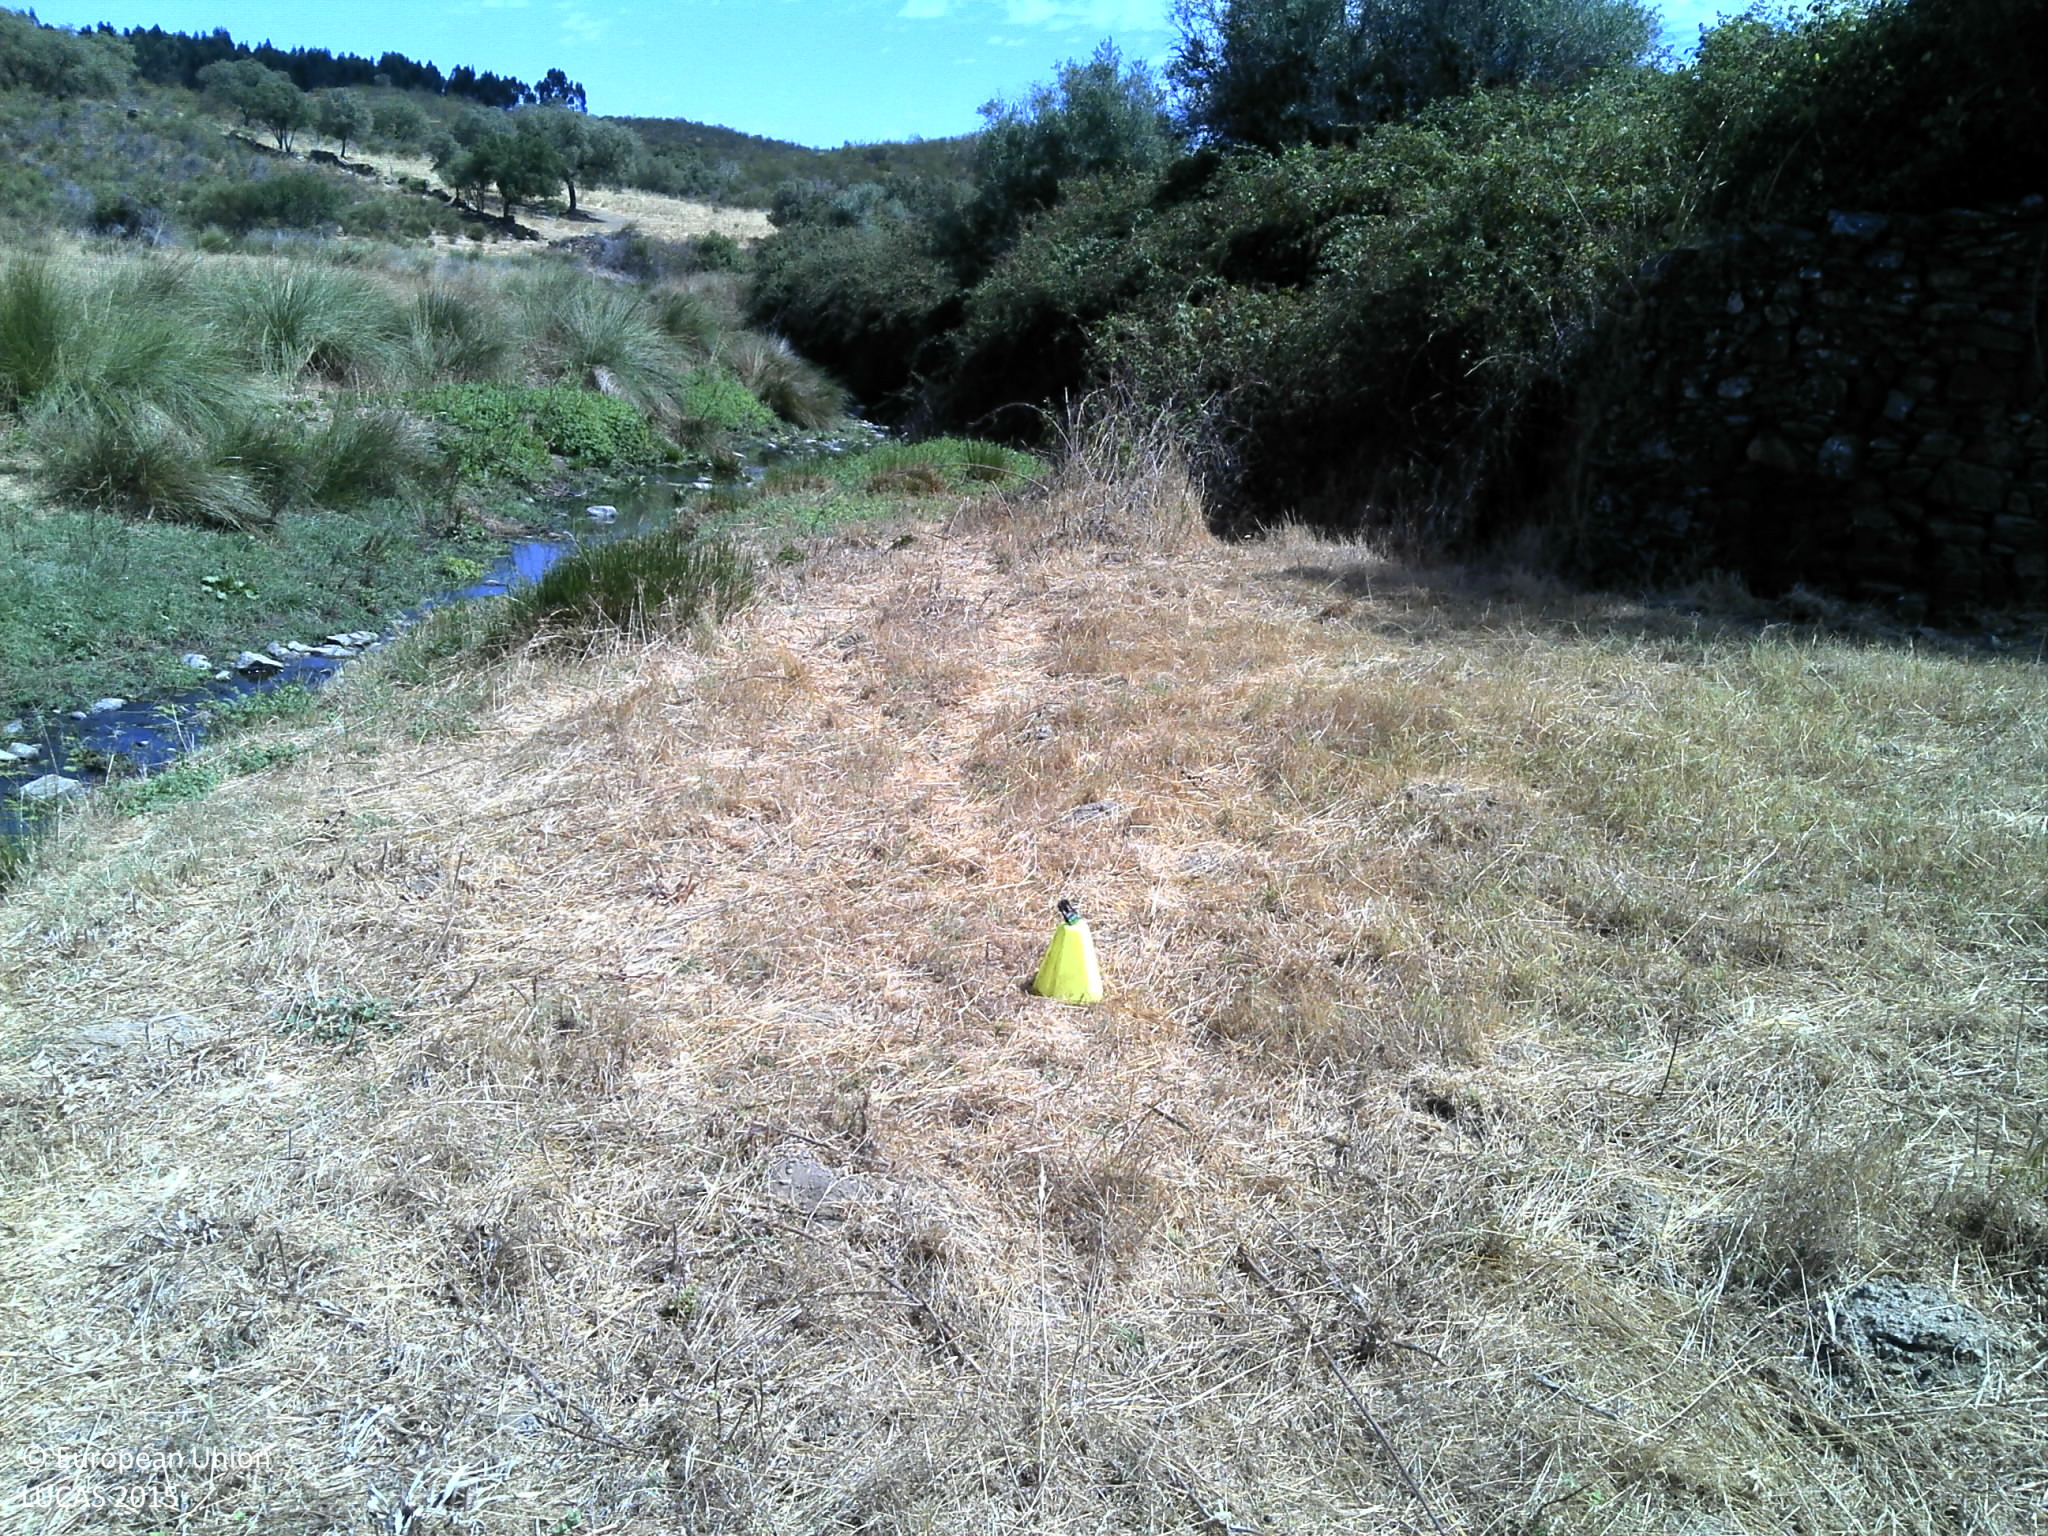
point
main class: Grassland
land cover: Grassland without tree/shrub cover
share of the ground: > 75 %
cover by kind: herbaceous plants 75 %, unconsolidated bare surface 25 %
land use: Agriculture (excluding fallow land and kitchen gardens)
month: August
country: PT
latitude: 39.5249
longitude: -7.6279
